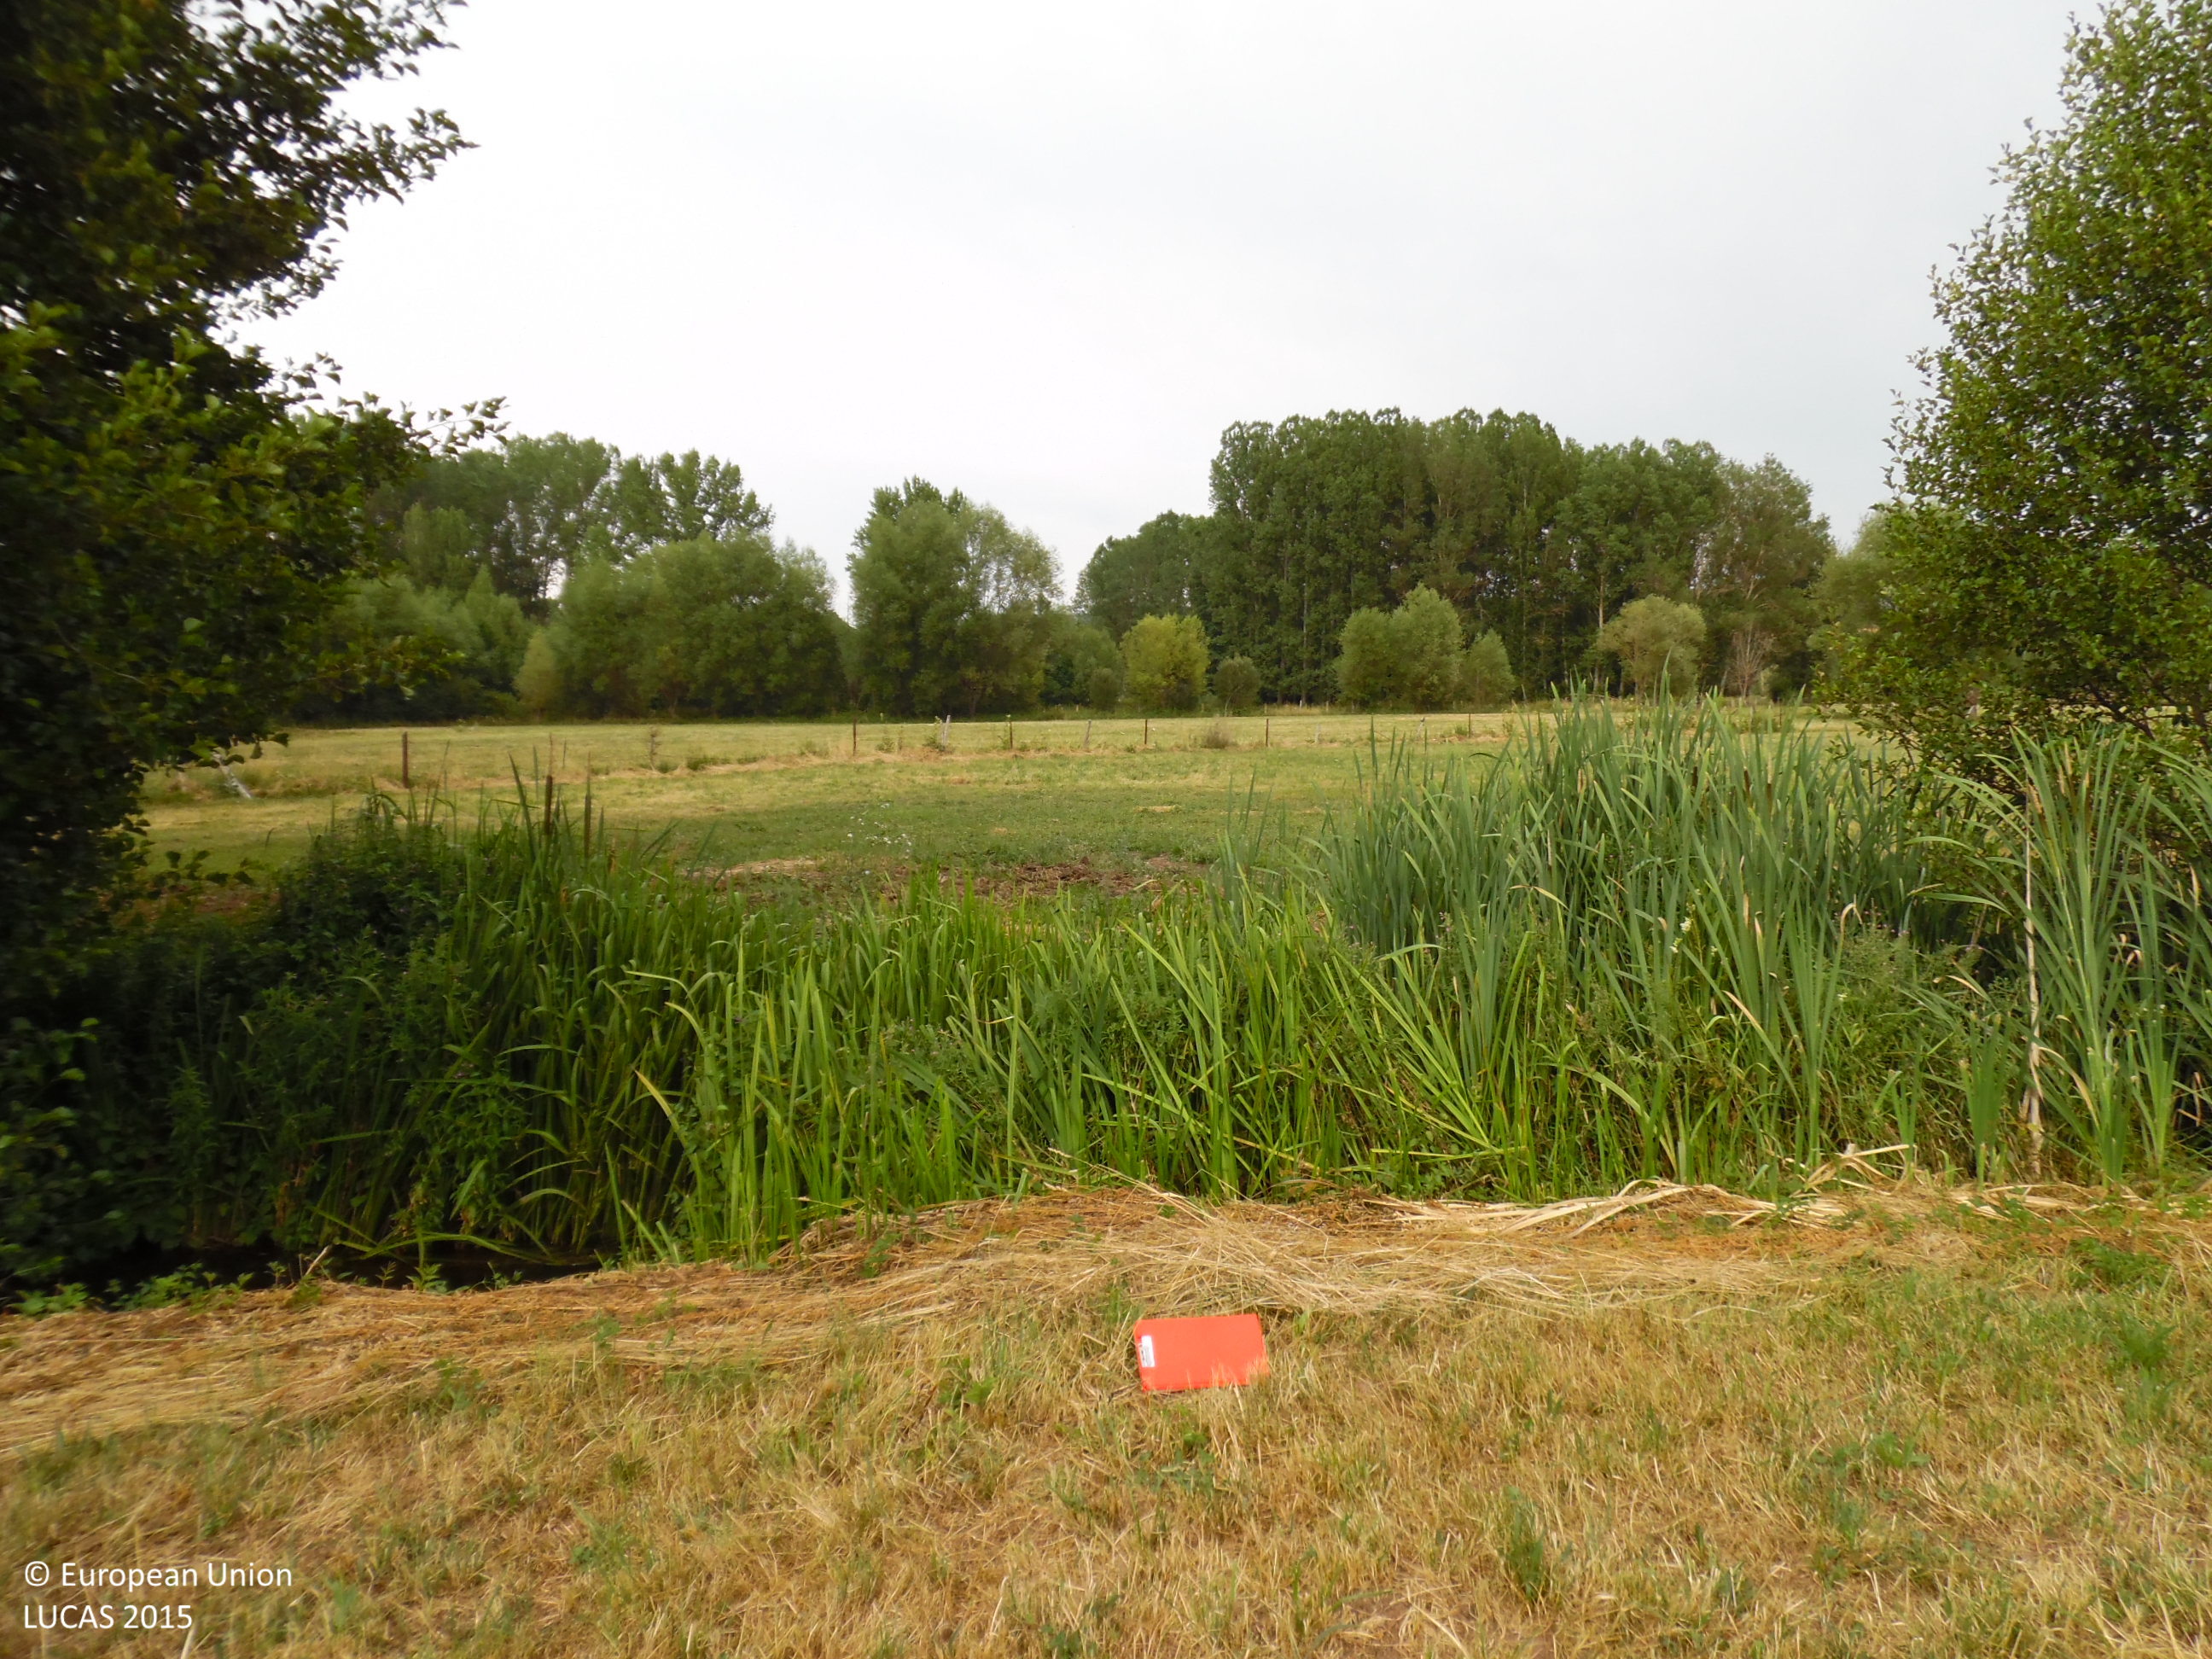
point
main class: Cropland
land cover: Temporary grasslands
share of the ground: > 75 %
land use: Agriculture (excluding fallow land and kitchen gardens)
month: July
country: ES
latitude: 42.7061
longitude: -5.8163
